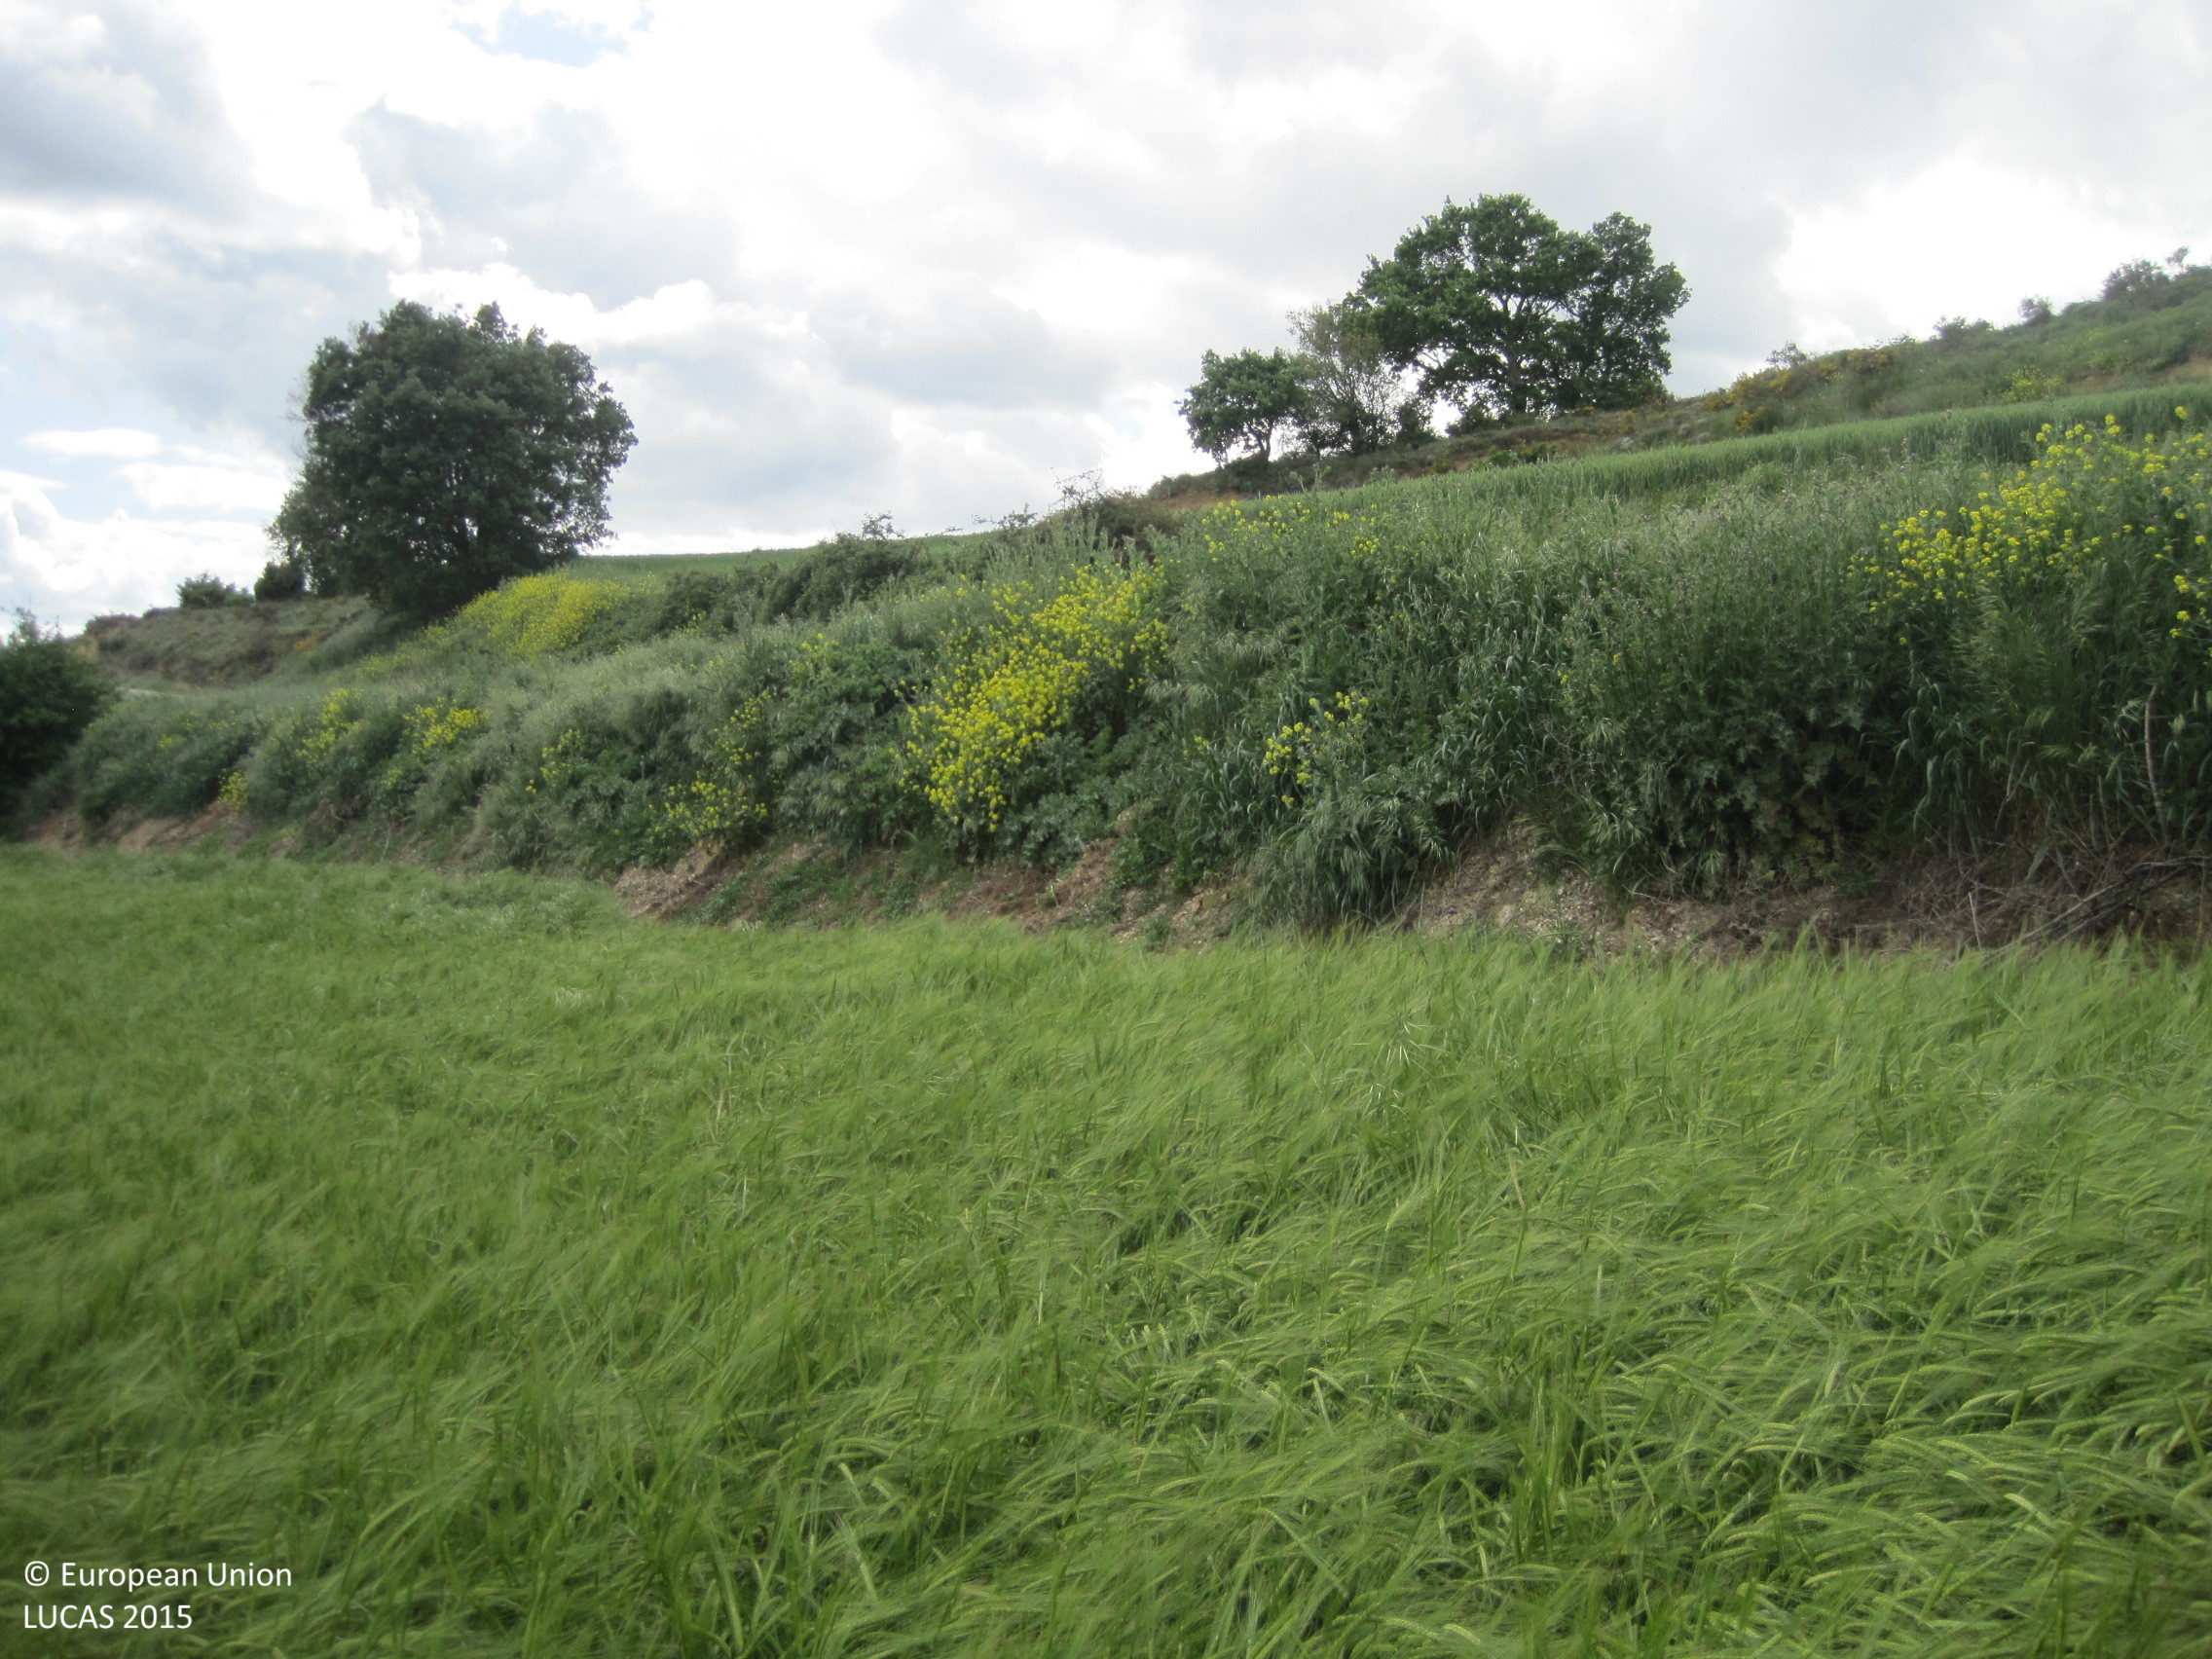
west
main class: Cropland
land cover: Barley
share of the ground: > 75 %
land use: Agriculture (excluding fallow land and kitchen gardens)
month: May
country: ES
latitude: 42.6851
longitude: -1.6938
